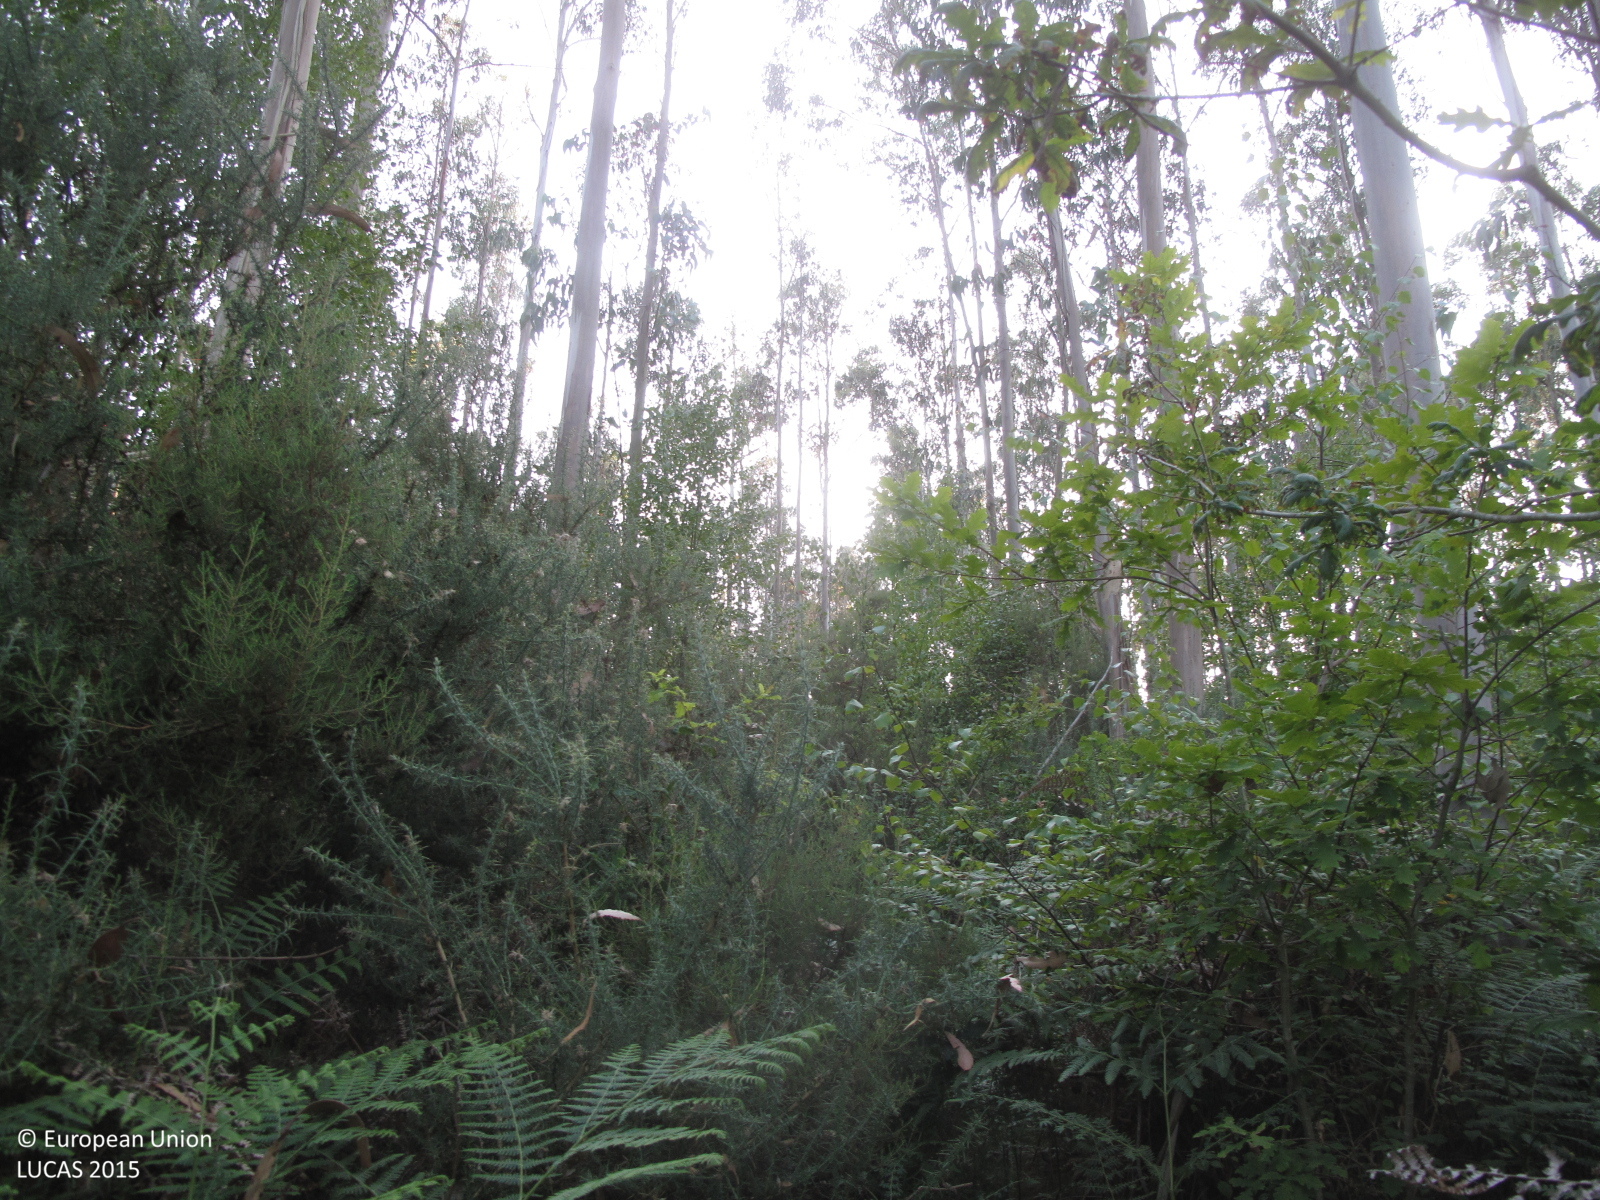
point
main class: Woodland
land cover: Broadleaved woodland
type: exotic forest
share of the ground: 25 - 50 %
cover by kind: shrubs 50 %, broadleaved forest trees 40 %, herbaceous plants 10 %
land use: Forestry
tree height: > 5 m
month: July
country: ES
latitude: 43.3037
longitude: -8.0567
